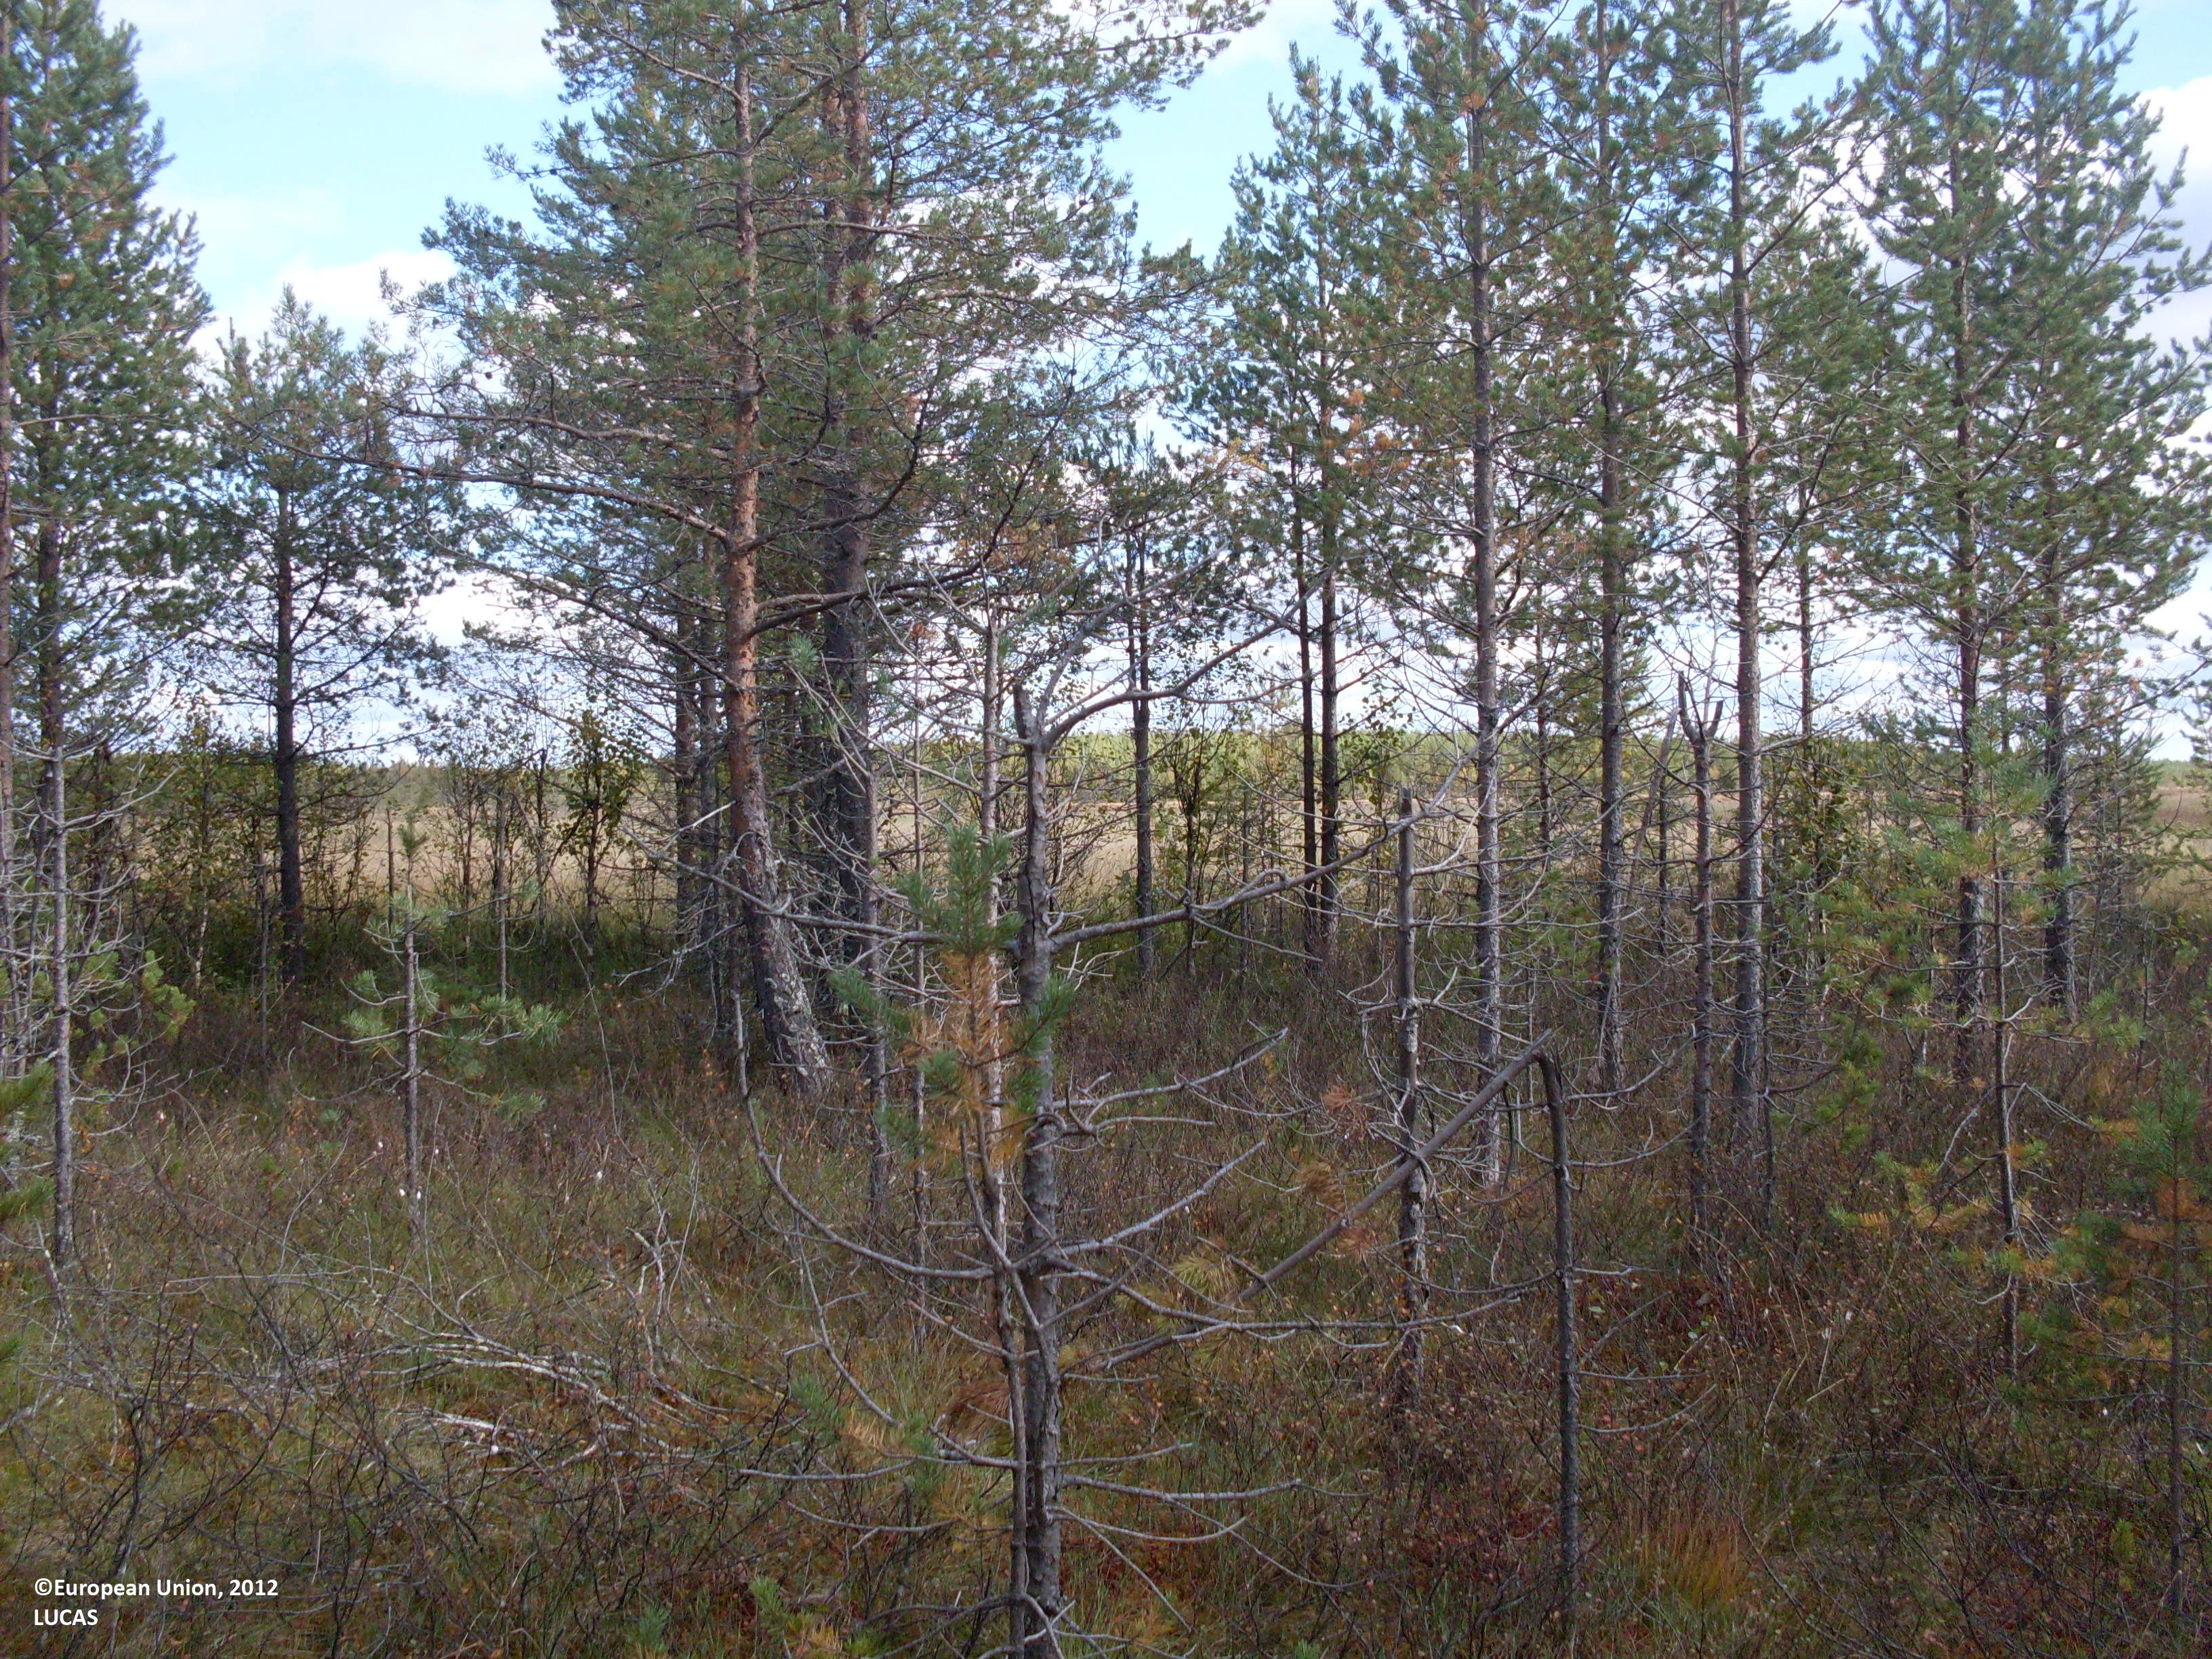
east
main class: Woodland
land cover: Pine dominated coniferous woodland
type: boreal forest
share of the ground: 25 - 50 %
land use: Forestry
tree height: > 5 m
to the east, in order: Pine dominated coniferous woodland; Inland marshes
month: September
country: FI
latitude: 64.1900
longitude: 30.1512
